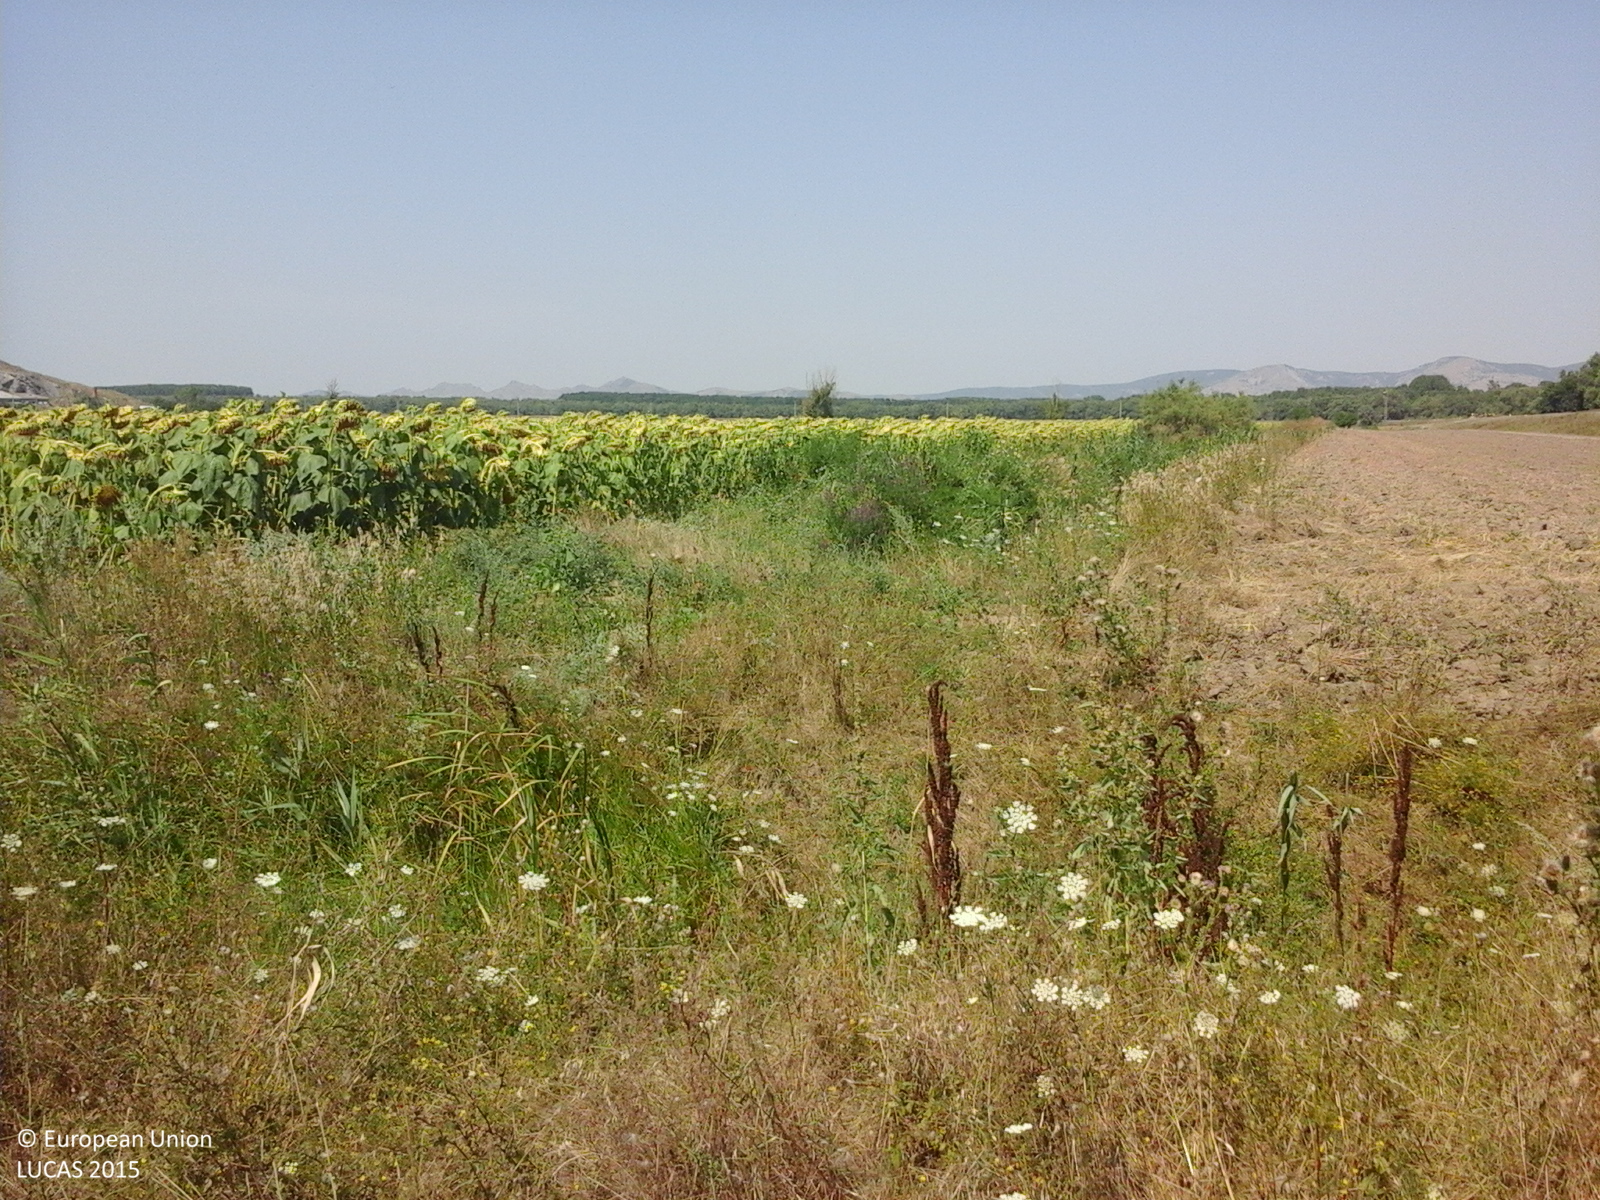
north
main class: Cropland
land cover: Lucerne
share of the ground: > 75 %
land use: Agriculture (excluding fallow land and kitchen gardens)
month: August
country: RO
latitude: 45.1299
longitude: 28.1612
